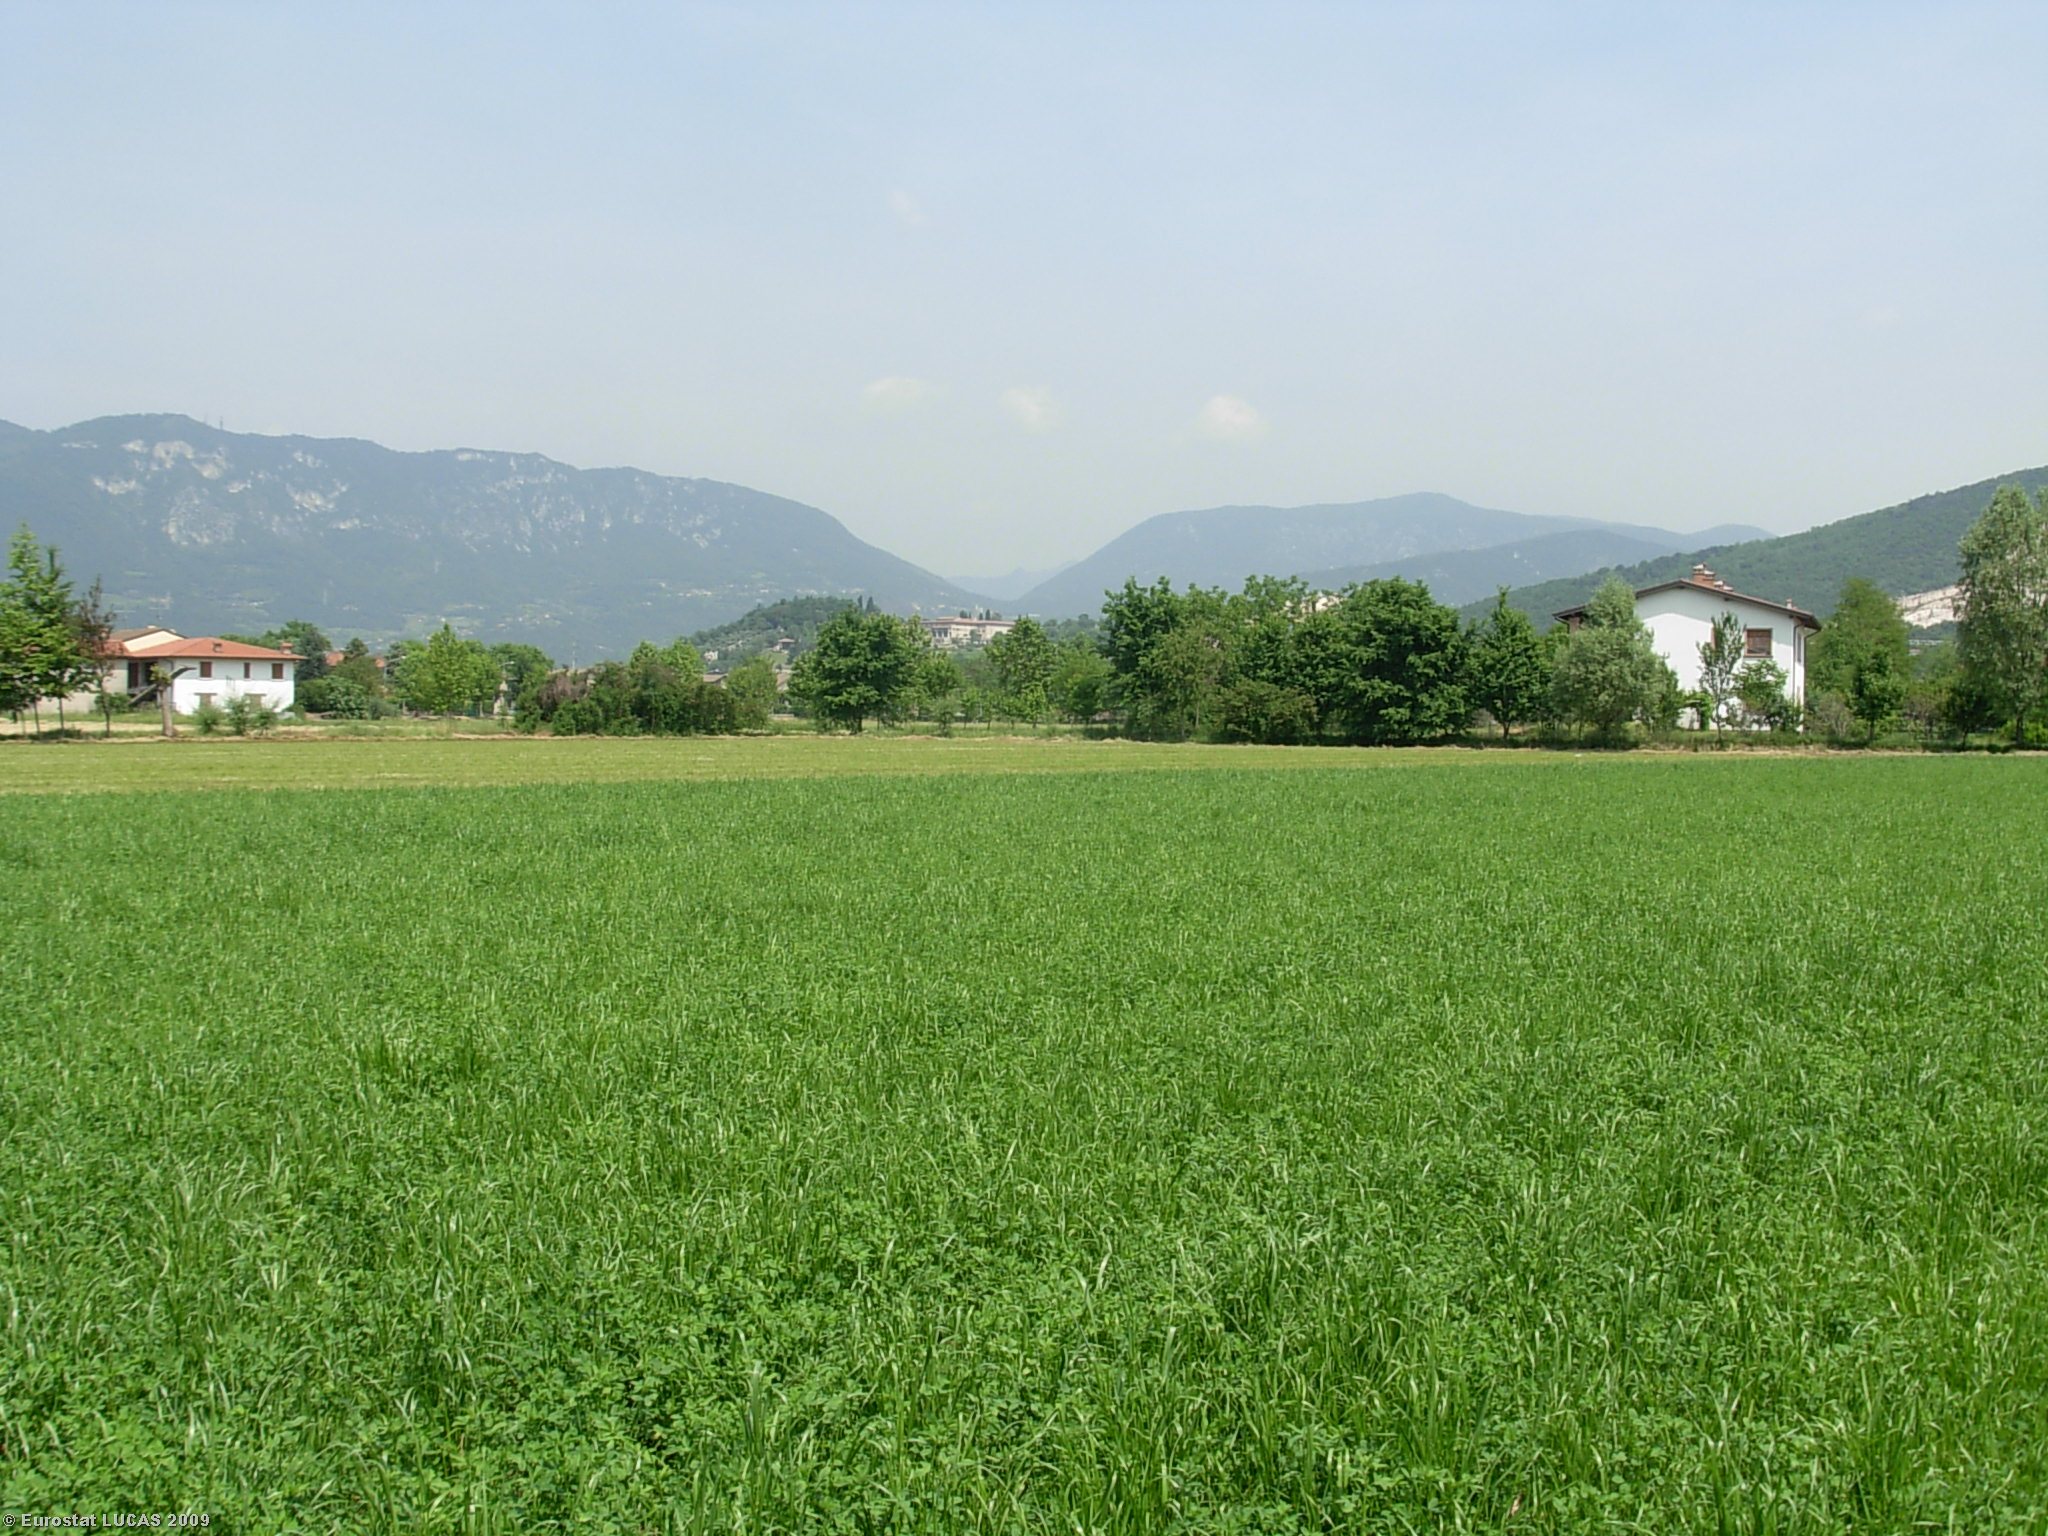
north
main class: Cropland
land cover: Lucerne
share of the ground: > 75 %
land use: Agriculture (excluding fallow land and kitchen gardens)
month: May
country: IT
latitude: 45.5039
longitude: 10.3194
